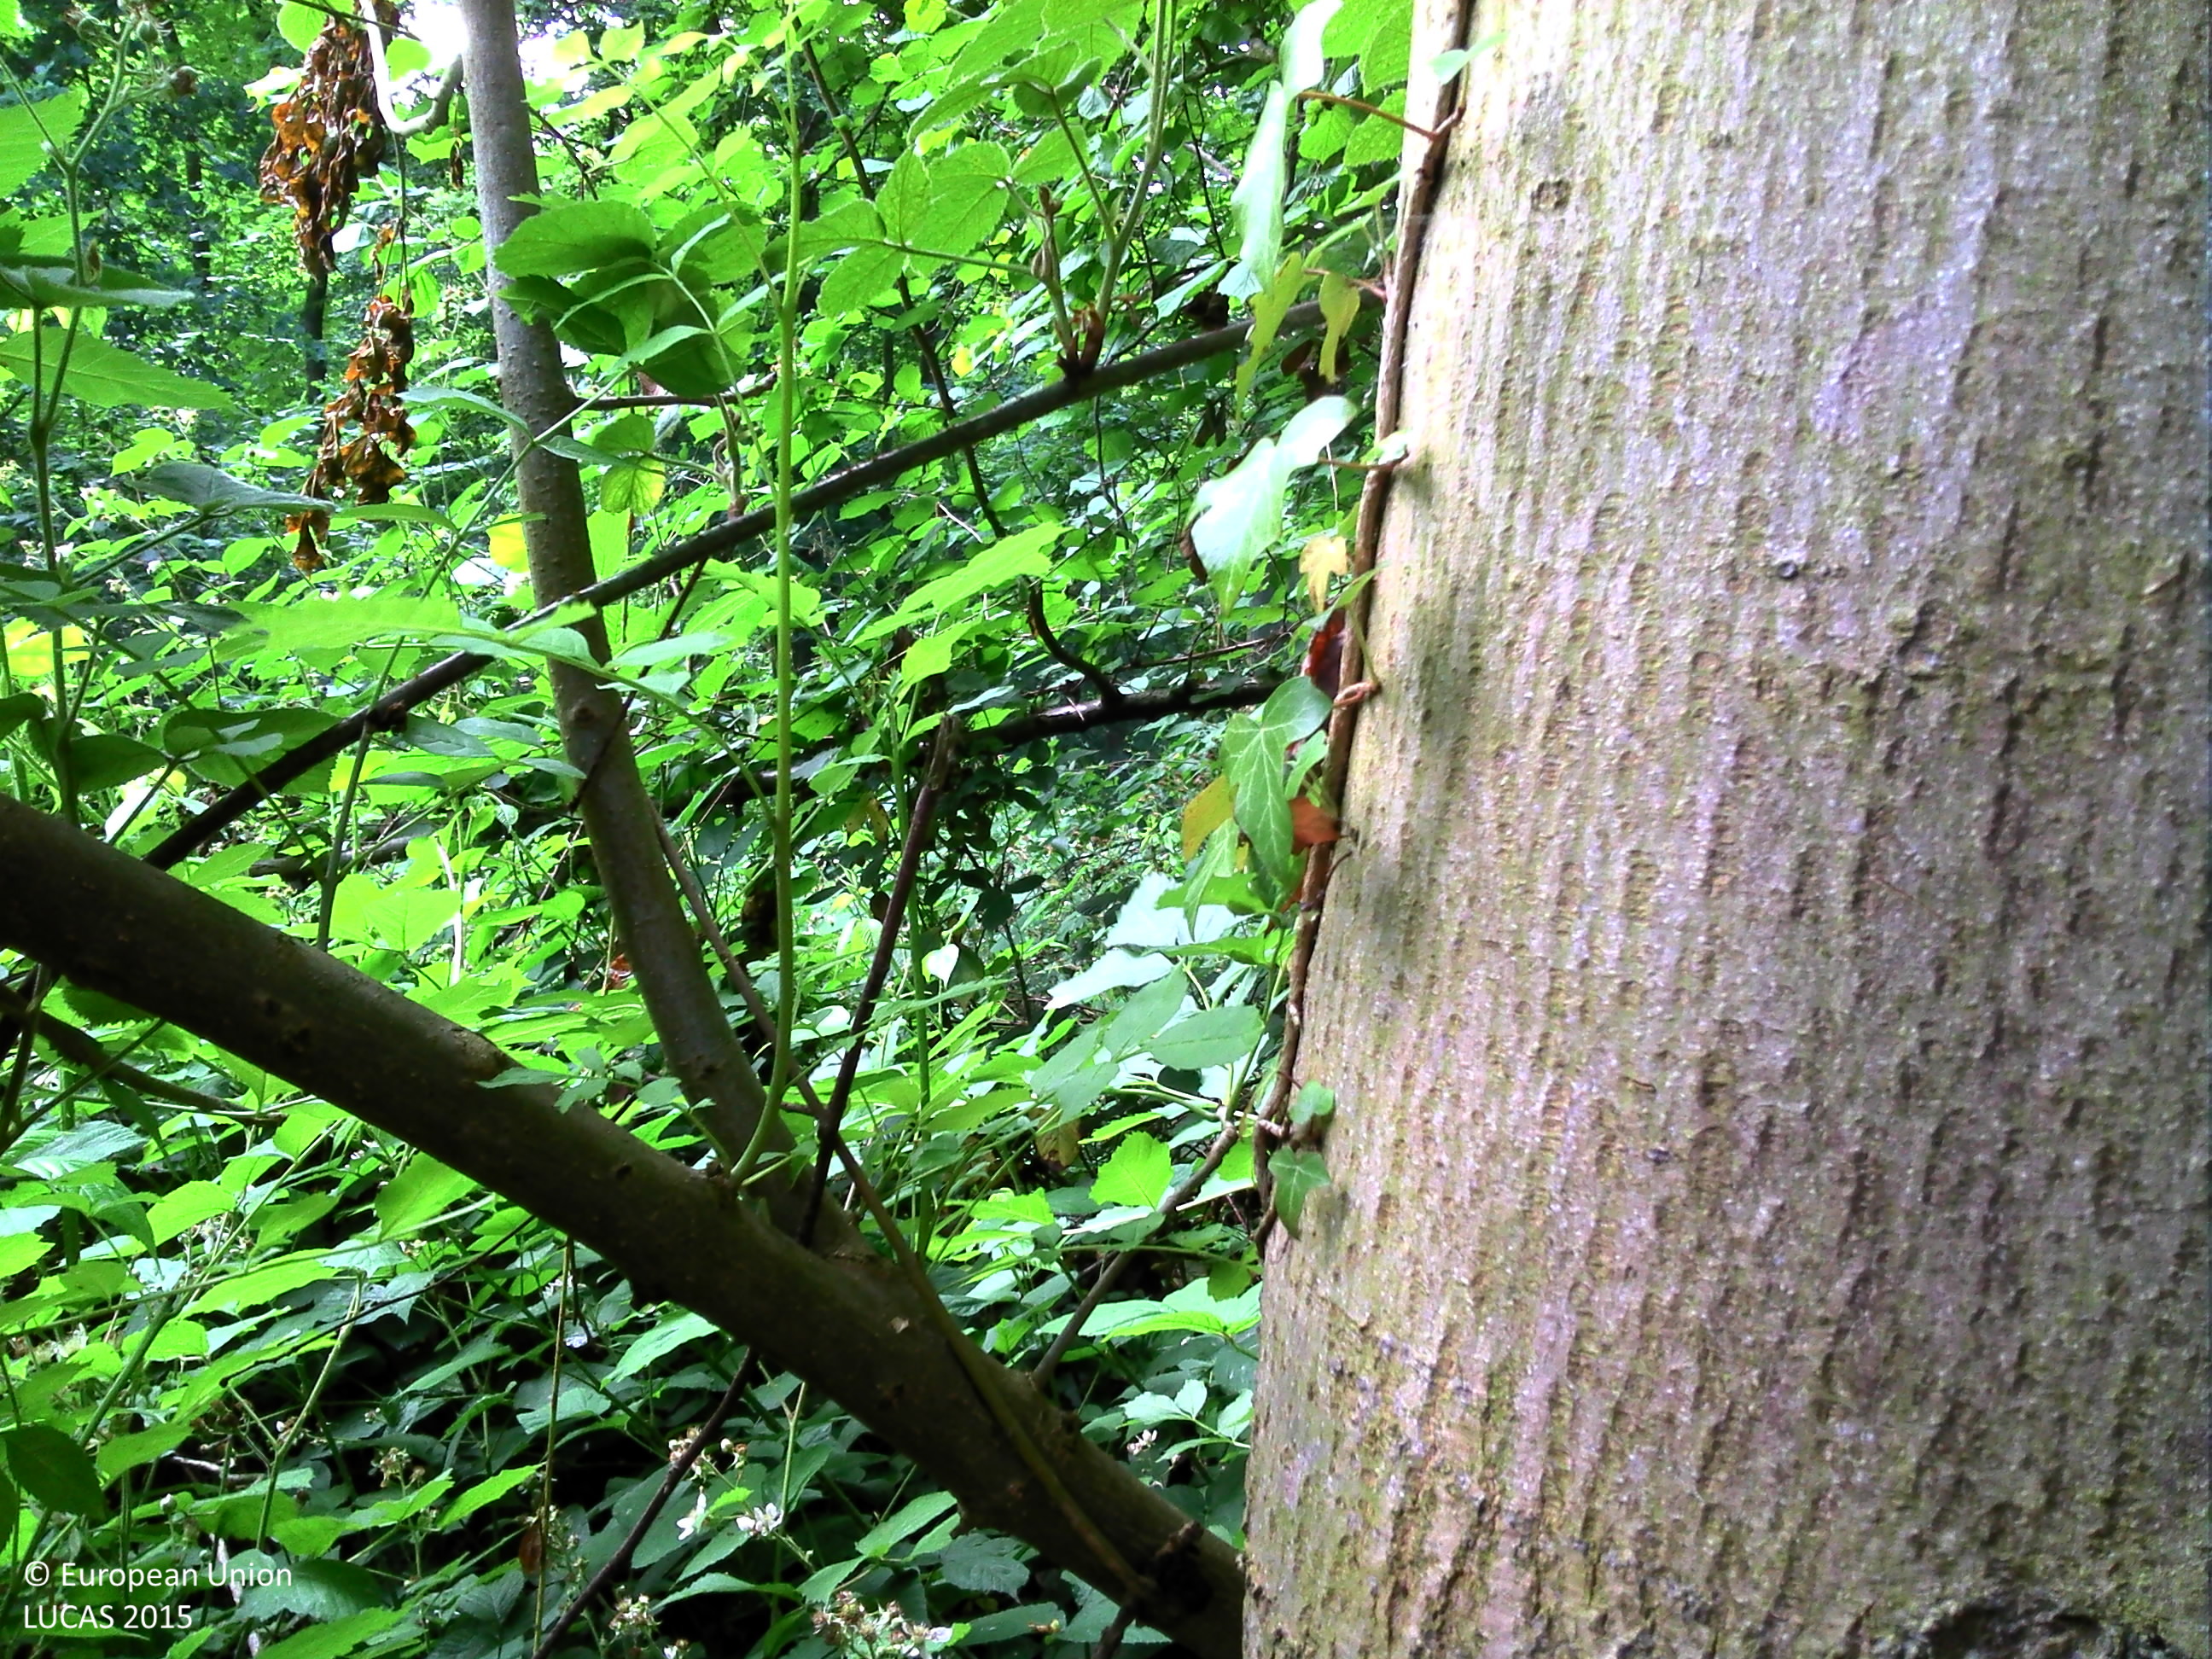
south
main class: Woodland
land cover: Broadleaved woodland
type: mesophytic deciduous forest
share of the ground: > 75 %
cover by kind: broadleaved forest trees 70 %, herbaceous plants 30 %
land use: Forestry
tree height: > 5 m
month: June
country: BE
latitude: 50.9323
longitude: 5.2594
